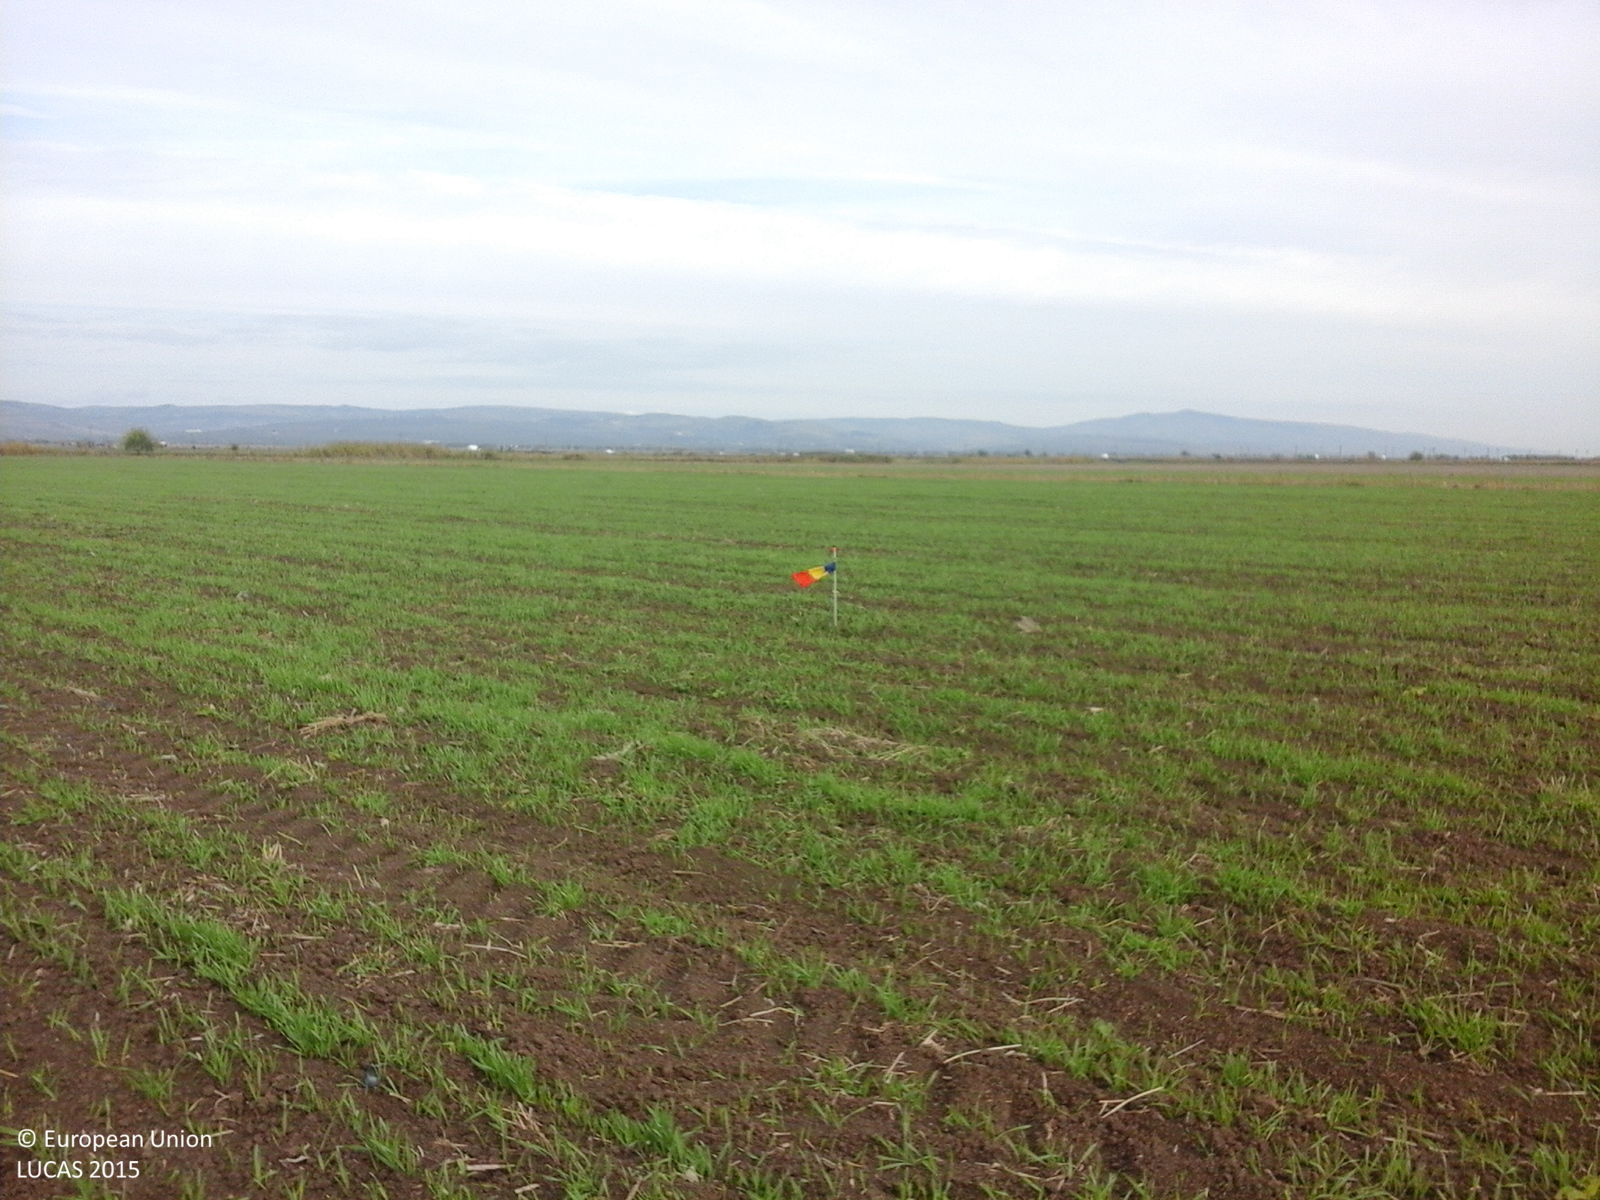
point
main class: Cropland
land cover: Common wheat
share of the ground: 50 - 75 %
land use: Agriculture (excluding fallow land and kitchen gardens)
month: October
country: RO
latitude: 44.9842
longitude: 26.3892
